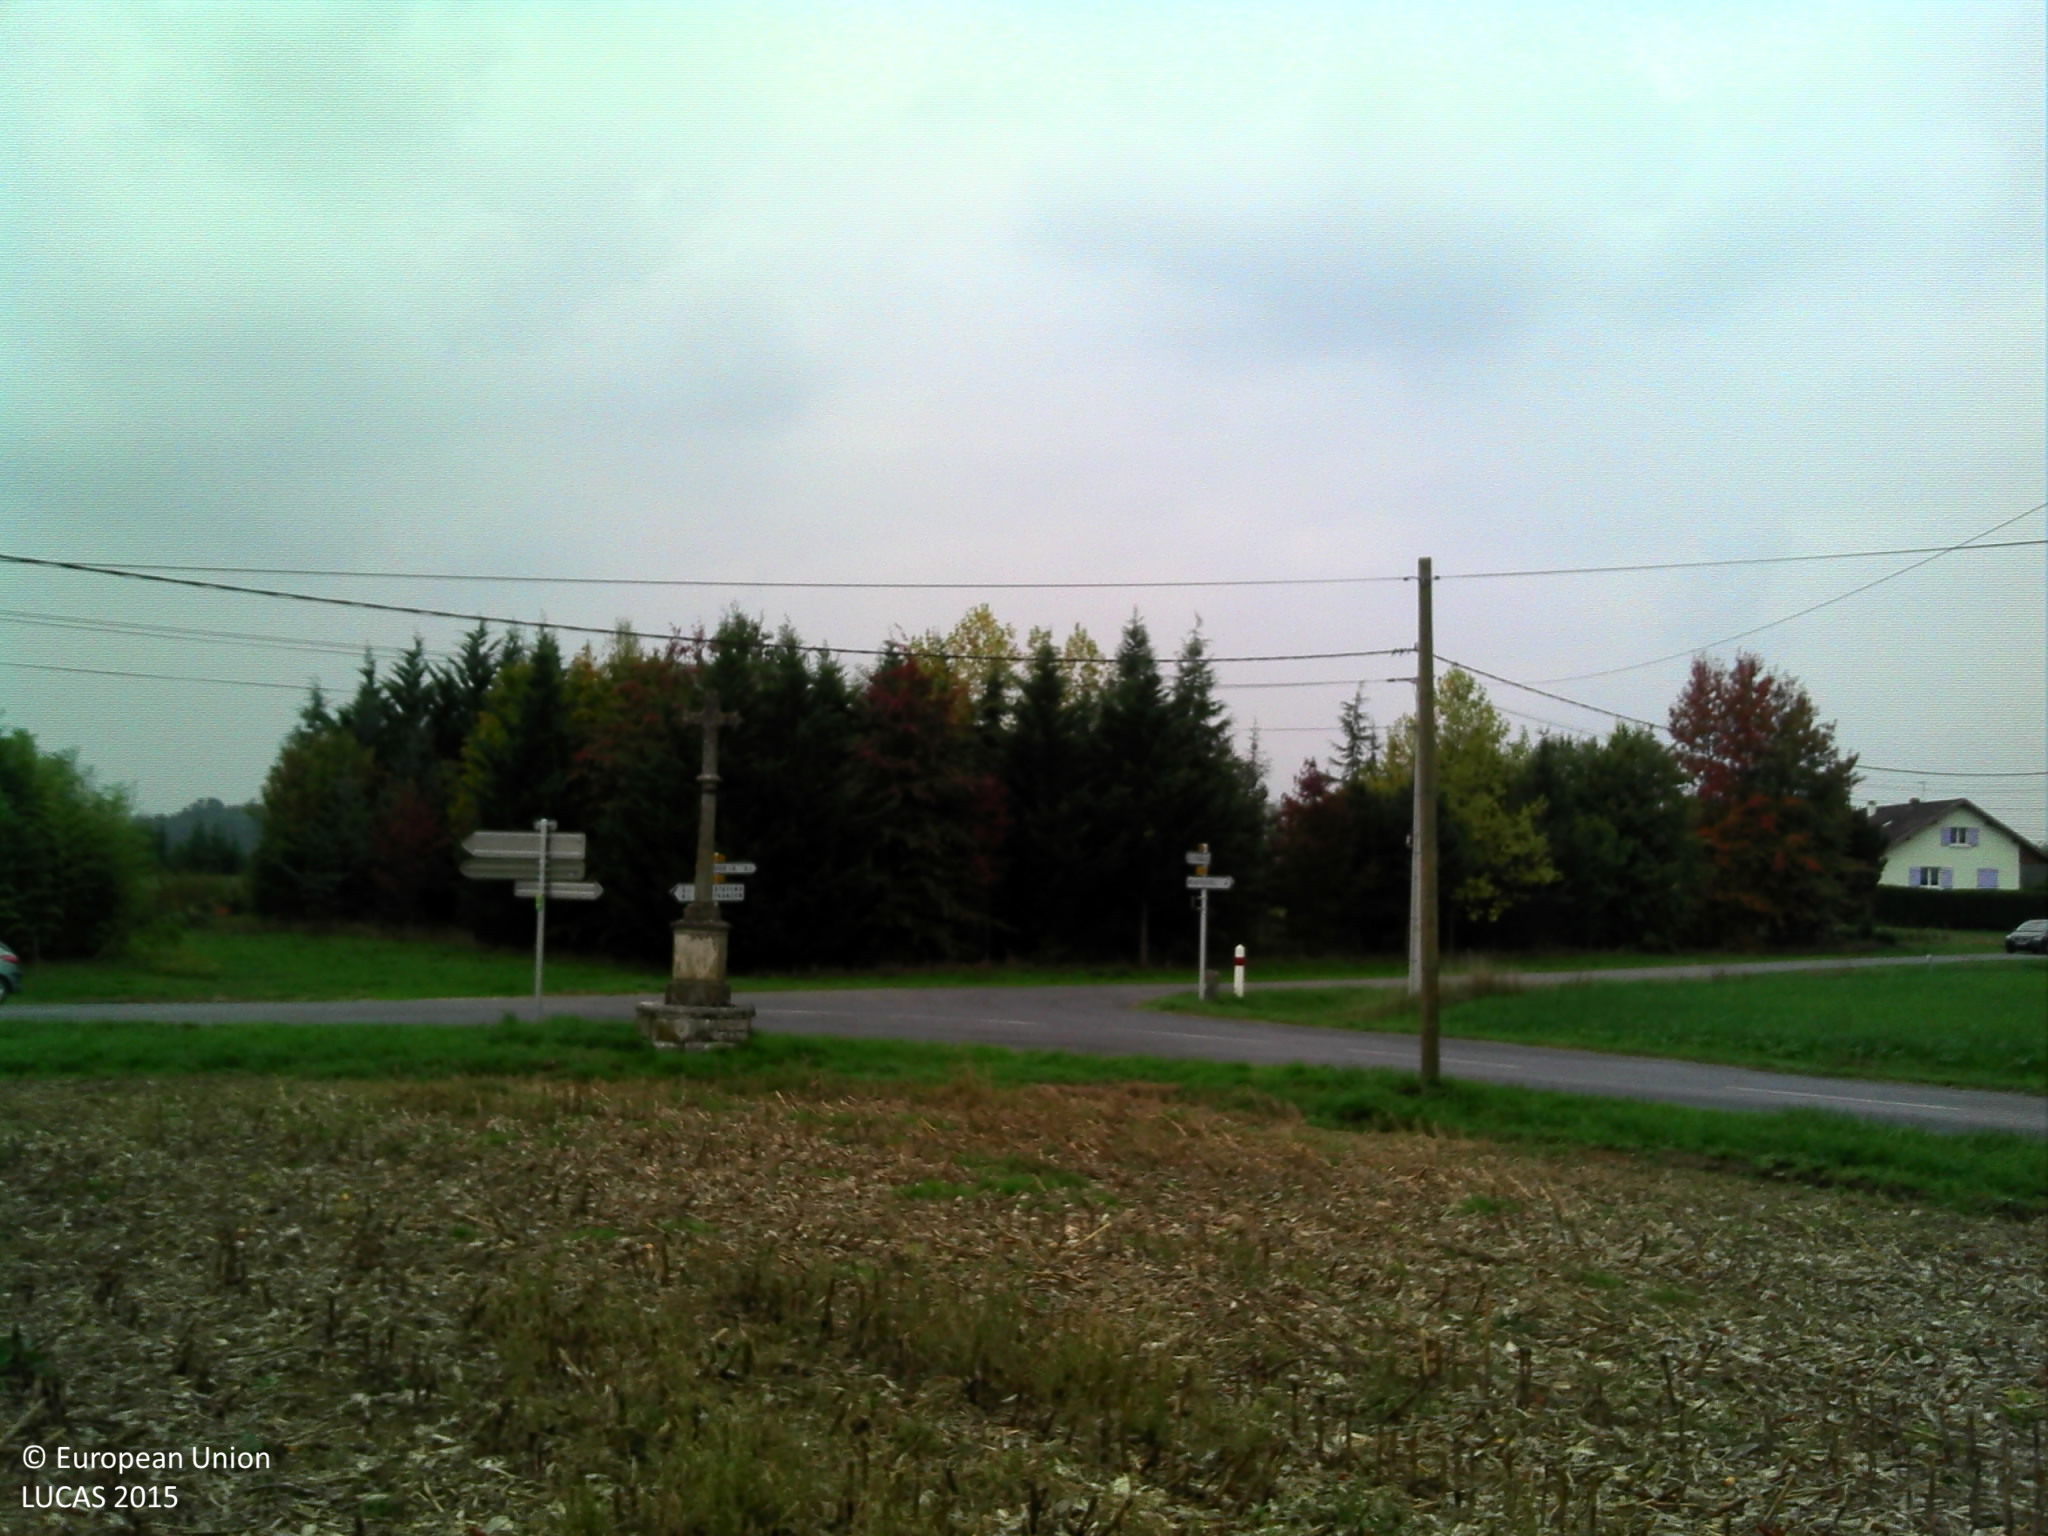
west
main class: Cropland
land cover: Maize
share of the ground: < 10 %
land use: Agriculture (excluding fallow land and kitchen gardens)
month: October
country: FR
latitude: 46.2923
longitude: 5.0829
